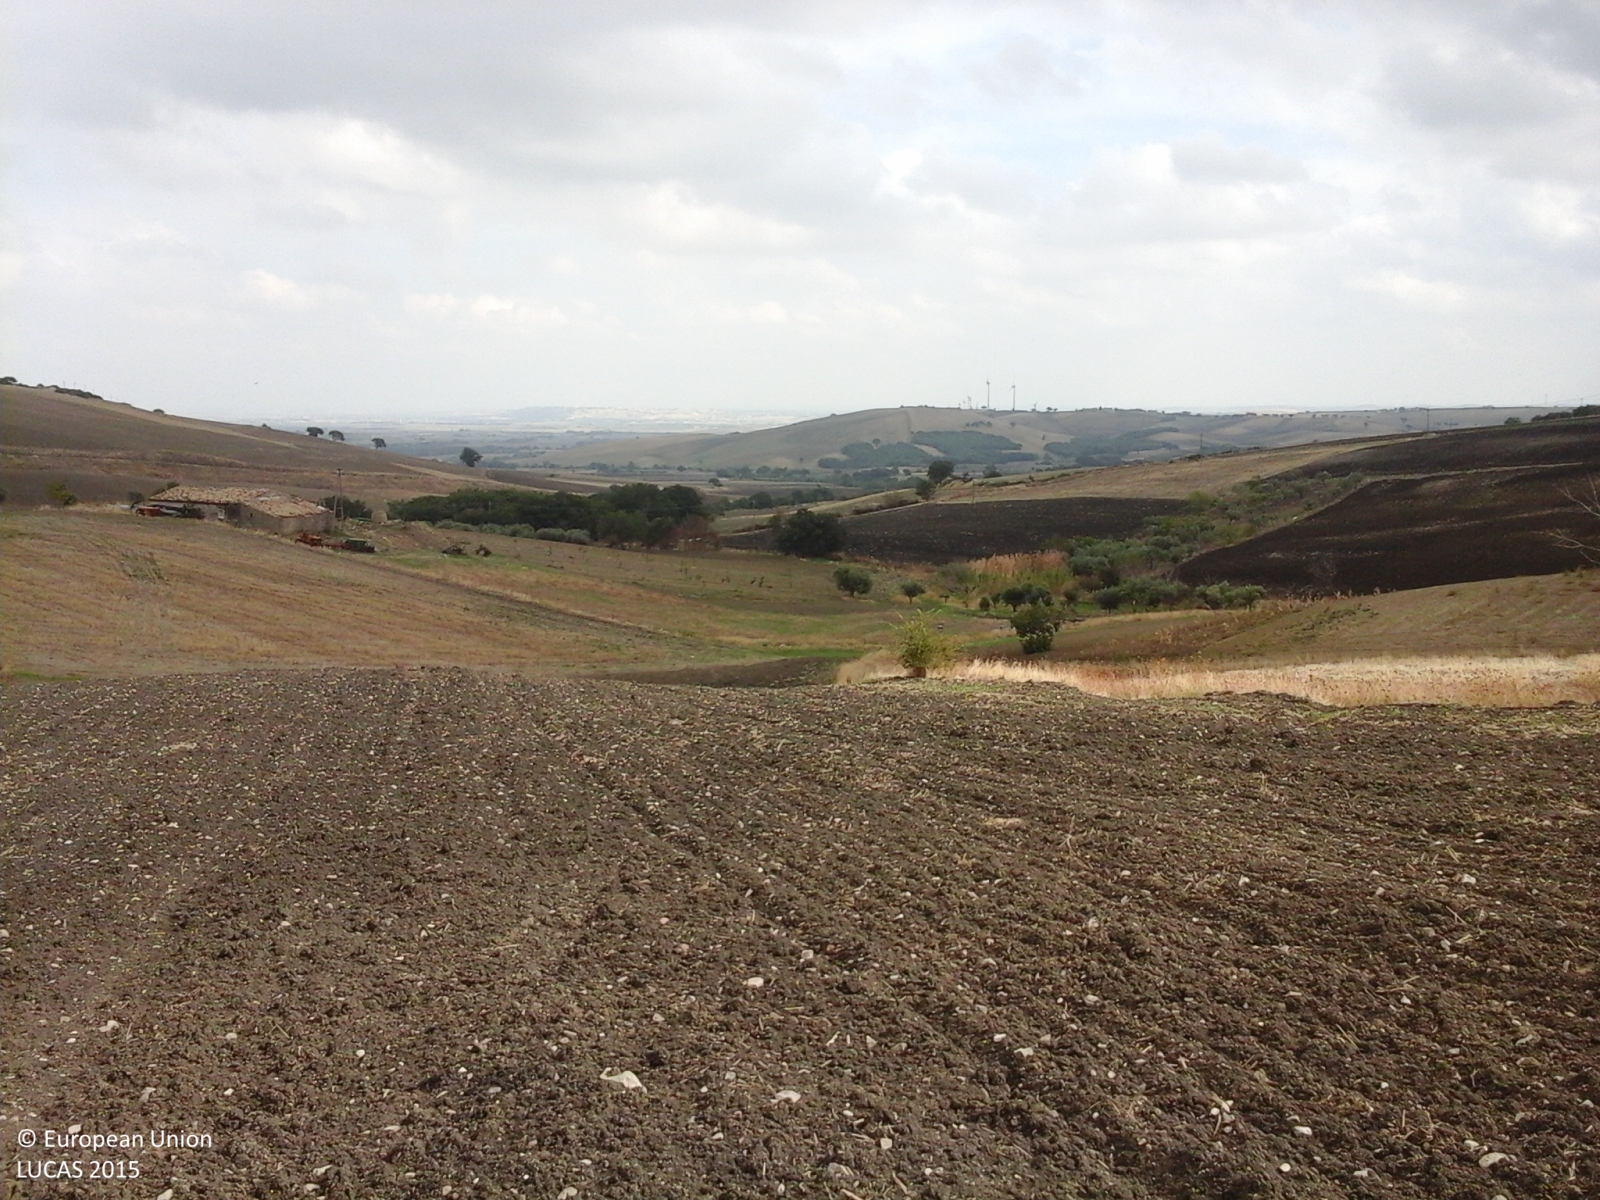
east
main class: Cropland
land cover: Durum wheat
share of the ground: > 75 %
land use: Agriculture (excluding fallow land and kitchen gardens)
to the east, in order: Durum wheat; Ditches and canals; Grassland without tree/shrub cover; Olive groves; Other bare soil; Abandoned hedges; Ditches and canals; Abandoned hedges
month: October
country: IT
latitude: 41.4734
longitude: 15.1436
